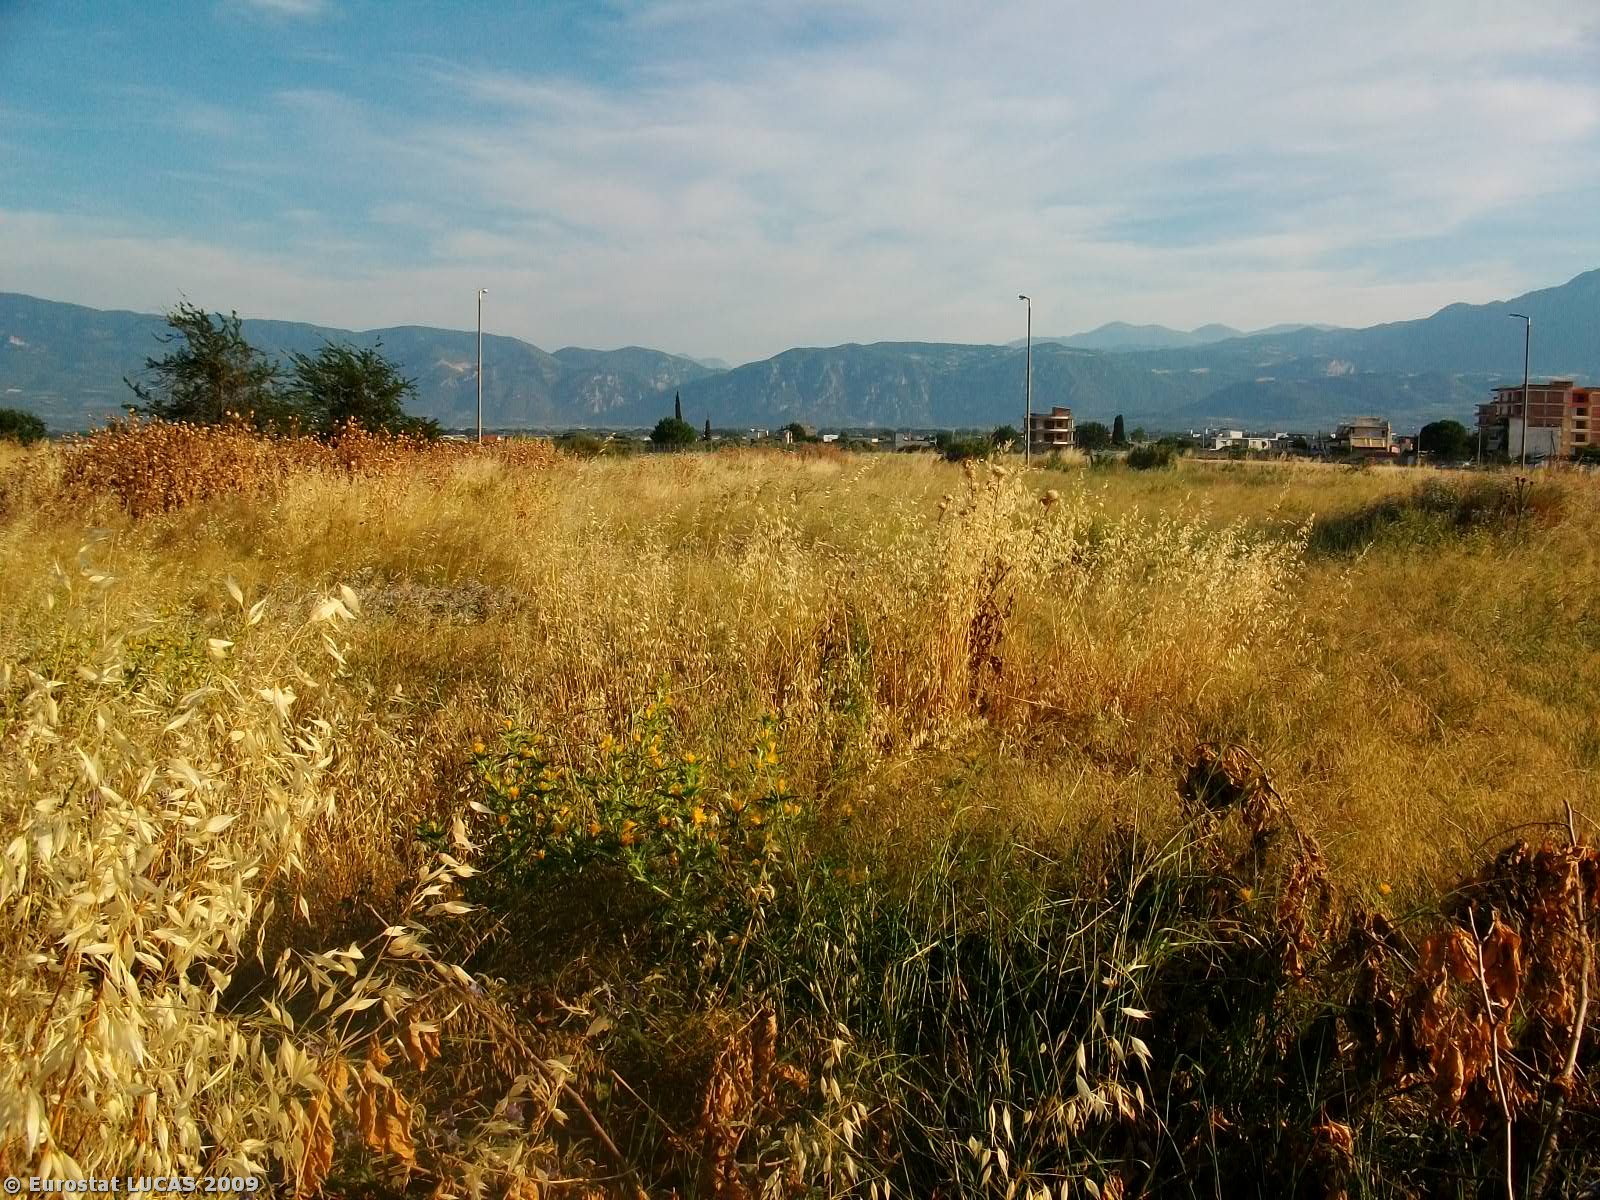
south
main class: Grassland
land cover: Grassland without tree/shrub cover
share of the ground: > 75 %
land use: Unused
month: June
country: GR
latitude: 38.8865
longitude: 22.4427
